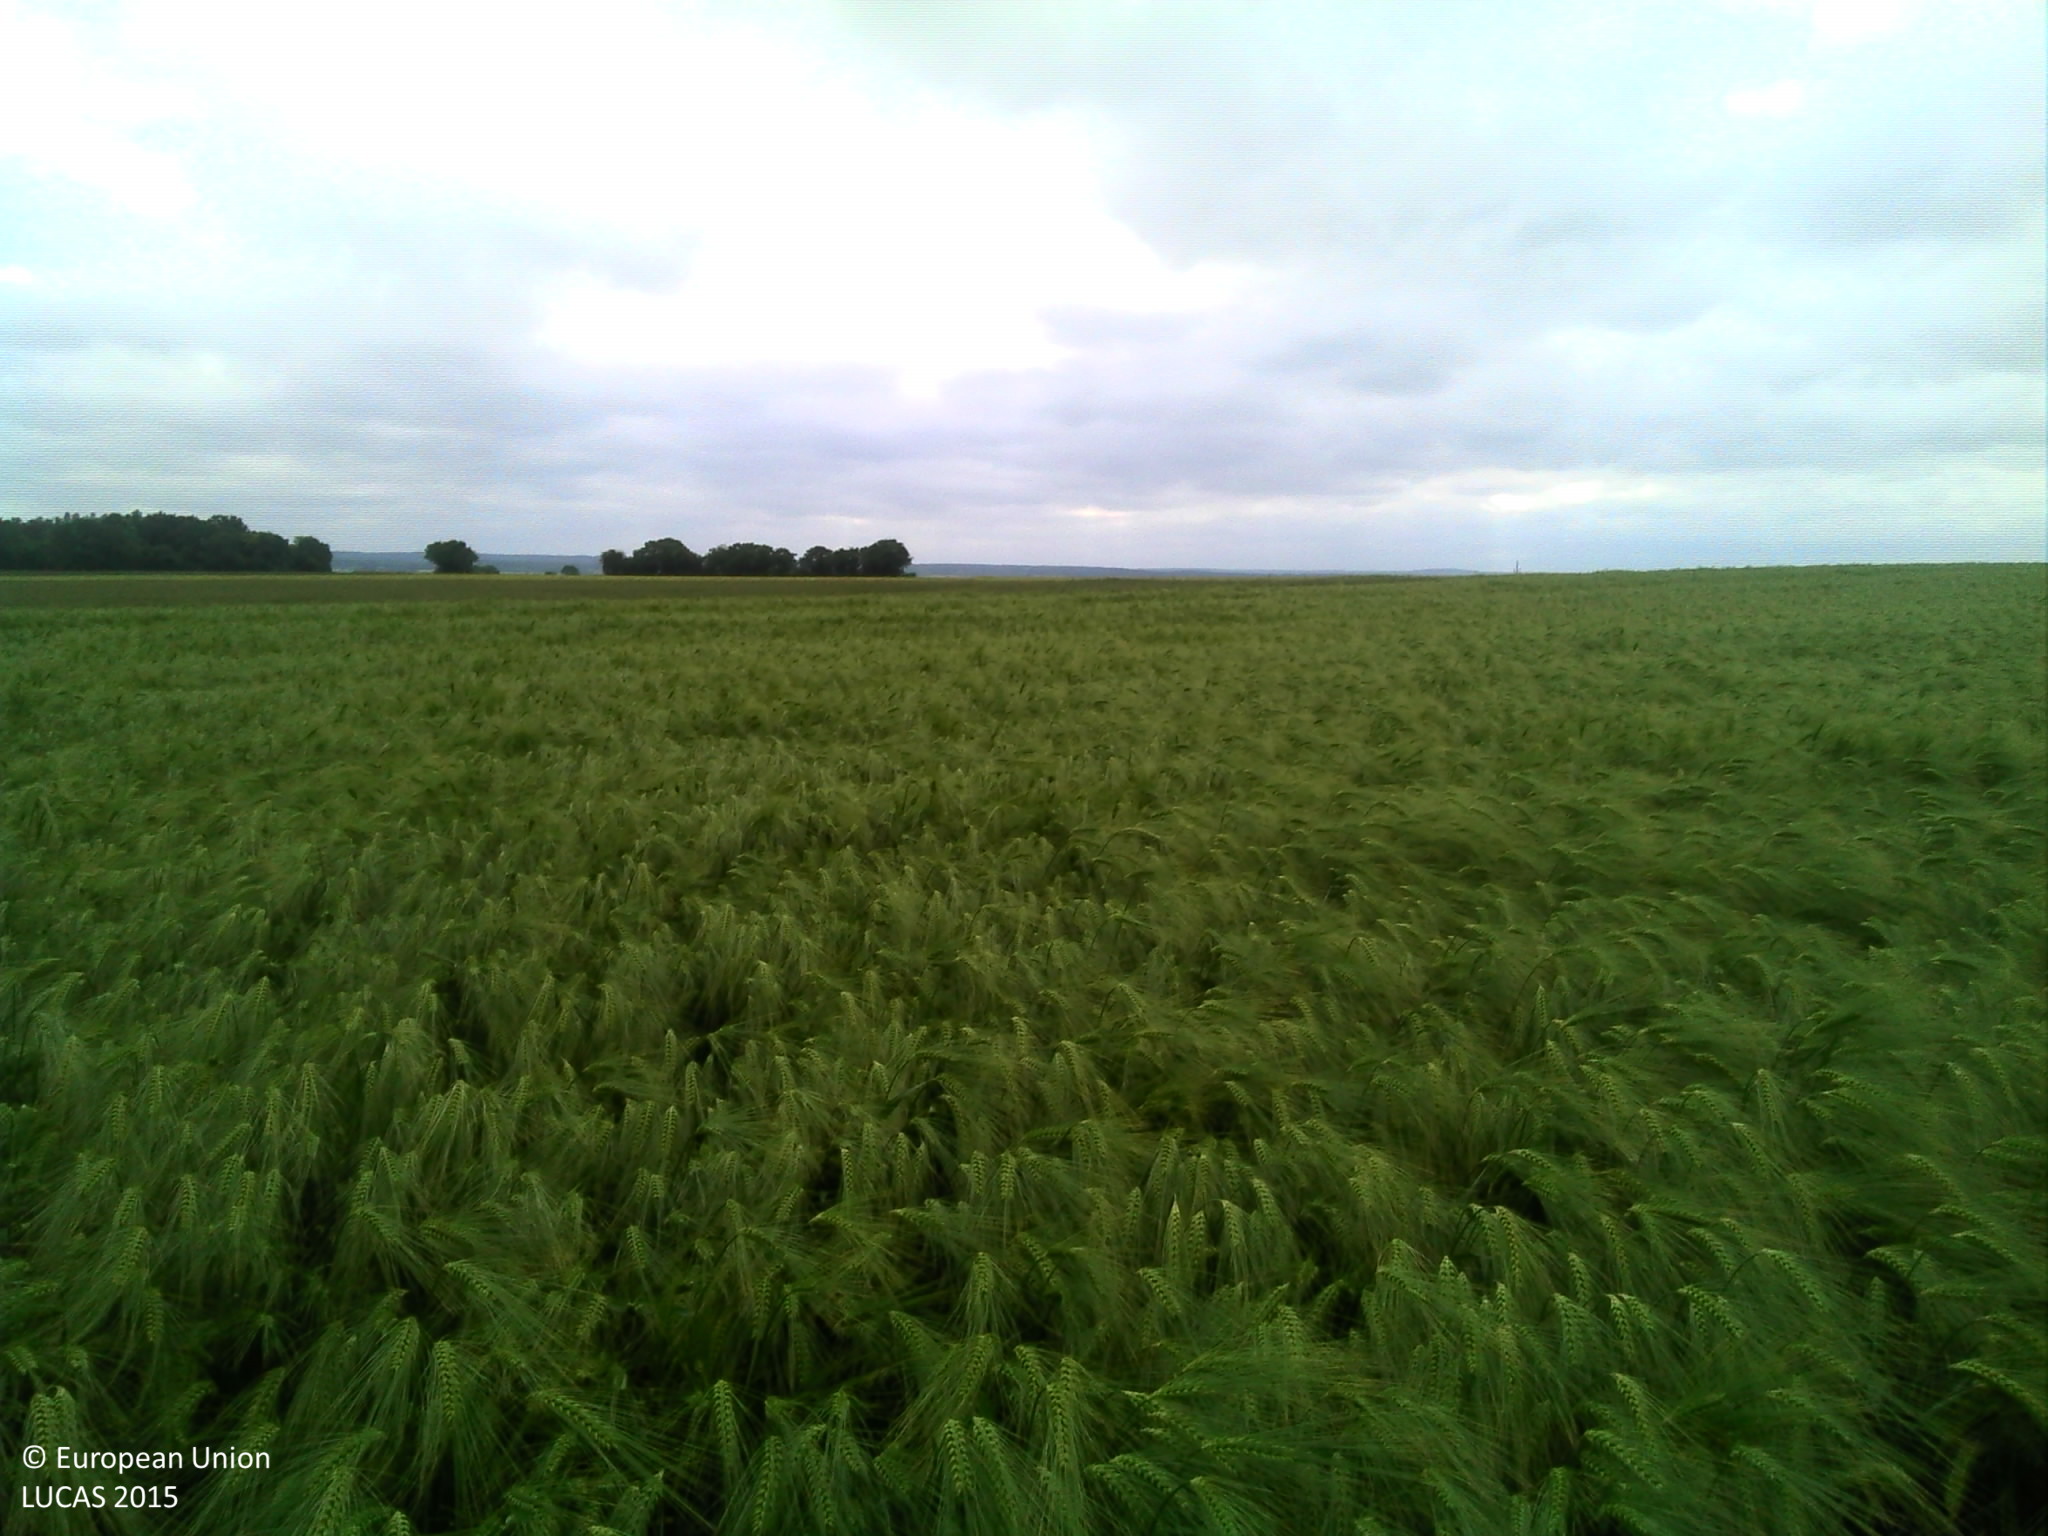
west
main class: Cropland
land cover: Barley
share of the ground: > 75 %
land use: Agriculture (excluding fallow land and kitchen gardens)
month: June
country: FR
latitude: 48.8431
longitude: 0.0641
